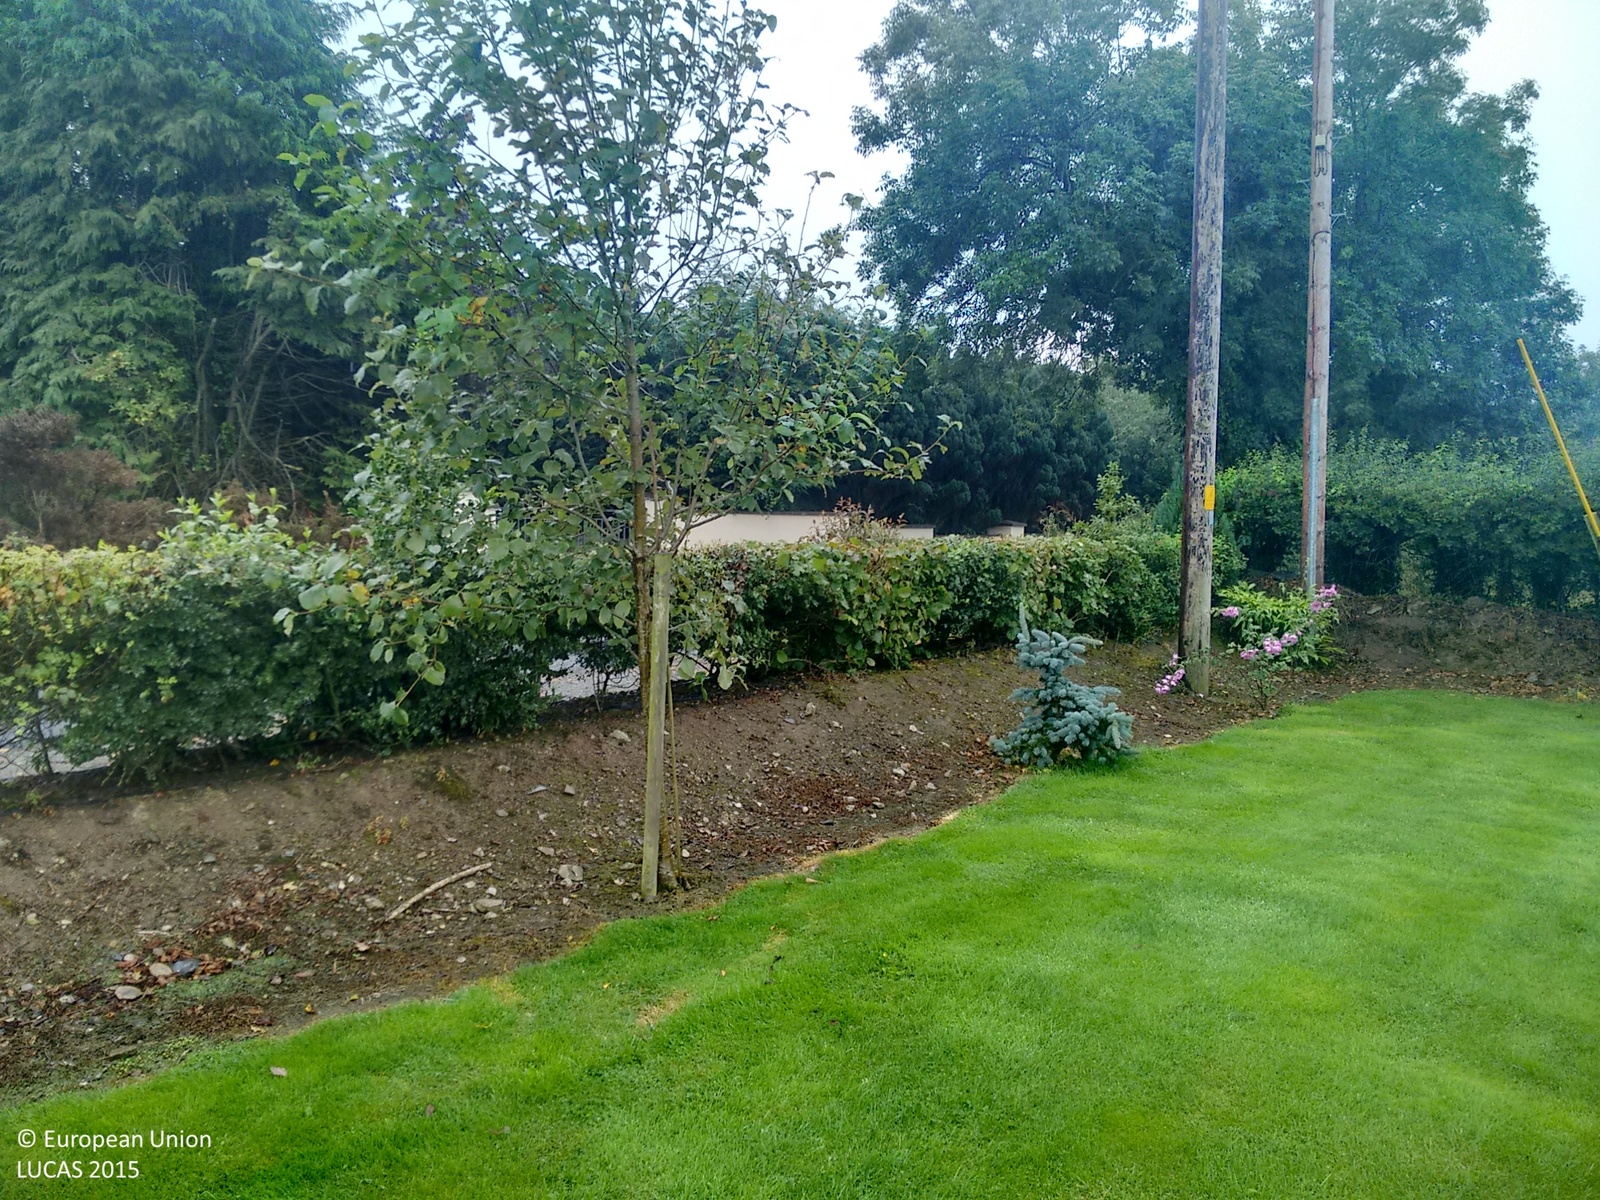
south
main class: Grassland
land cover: Grassland without tree/shrub cover
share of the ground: > 75 %
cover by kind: herbaceous plants 100 %
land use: Residential
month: August
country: IE
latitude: 54.0030
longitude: -6.7791
